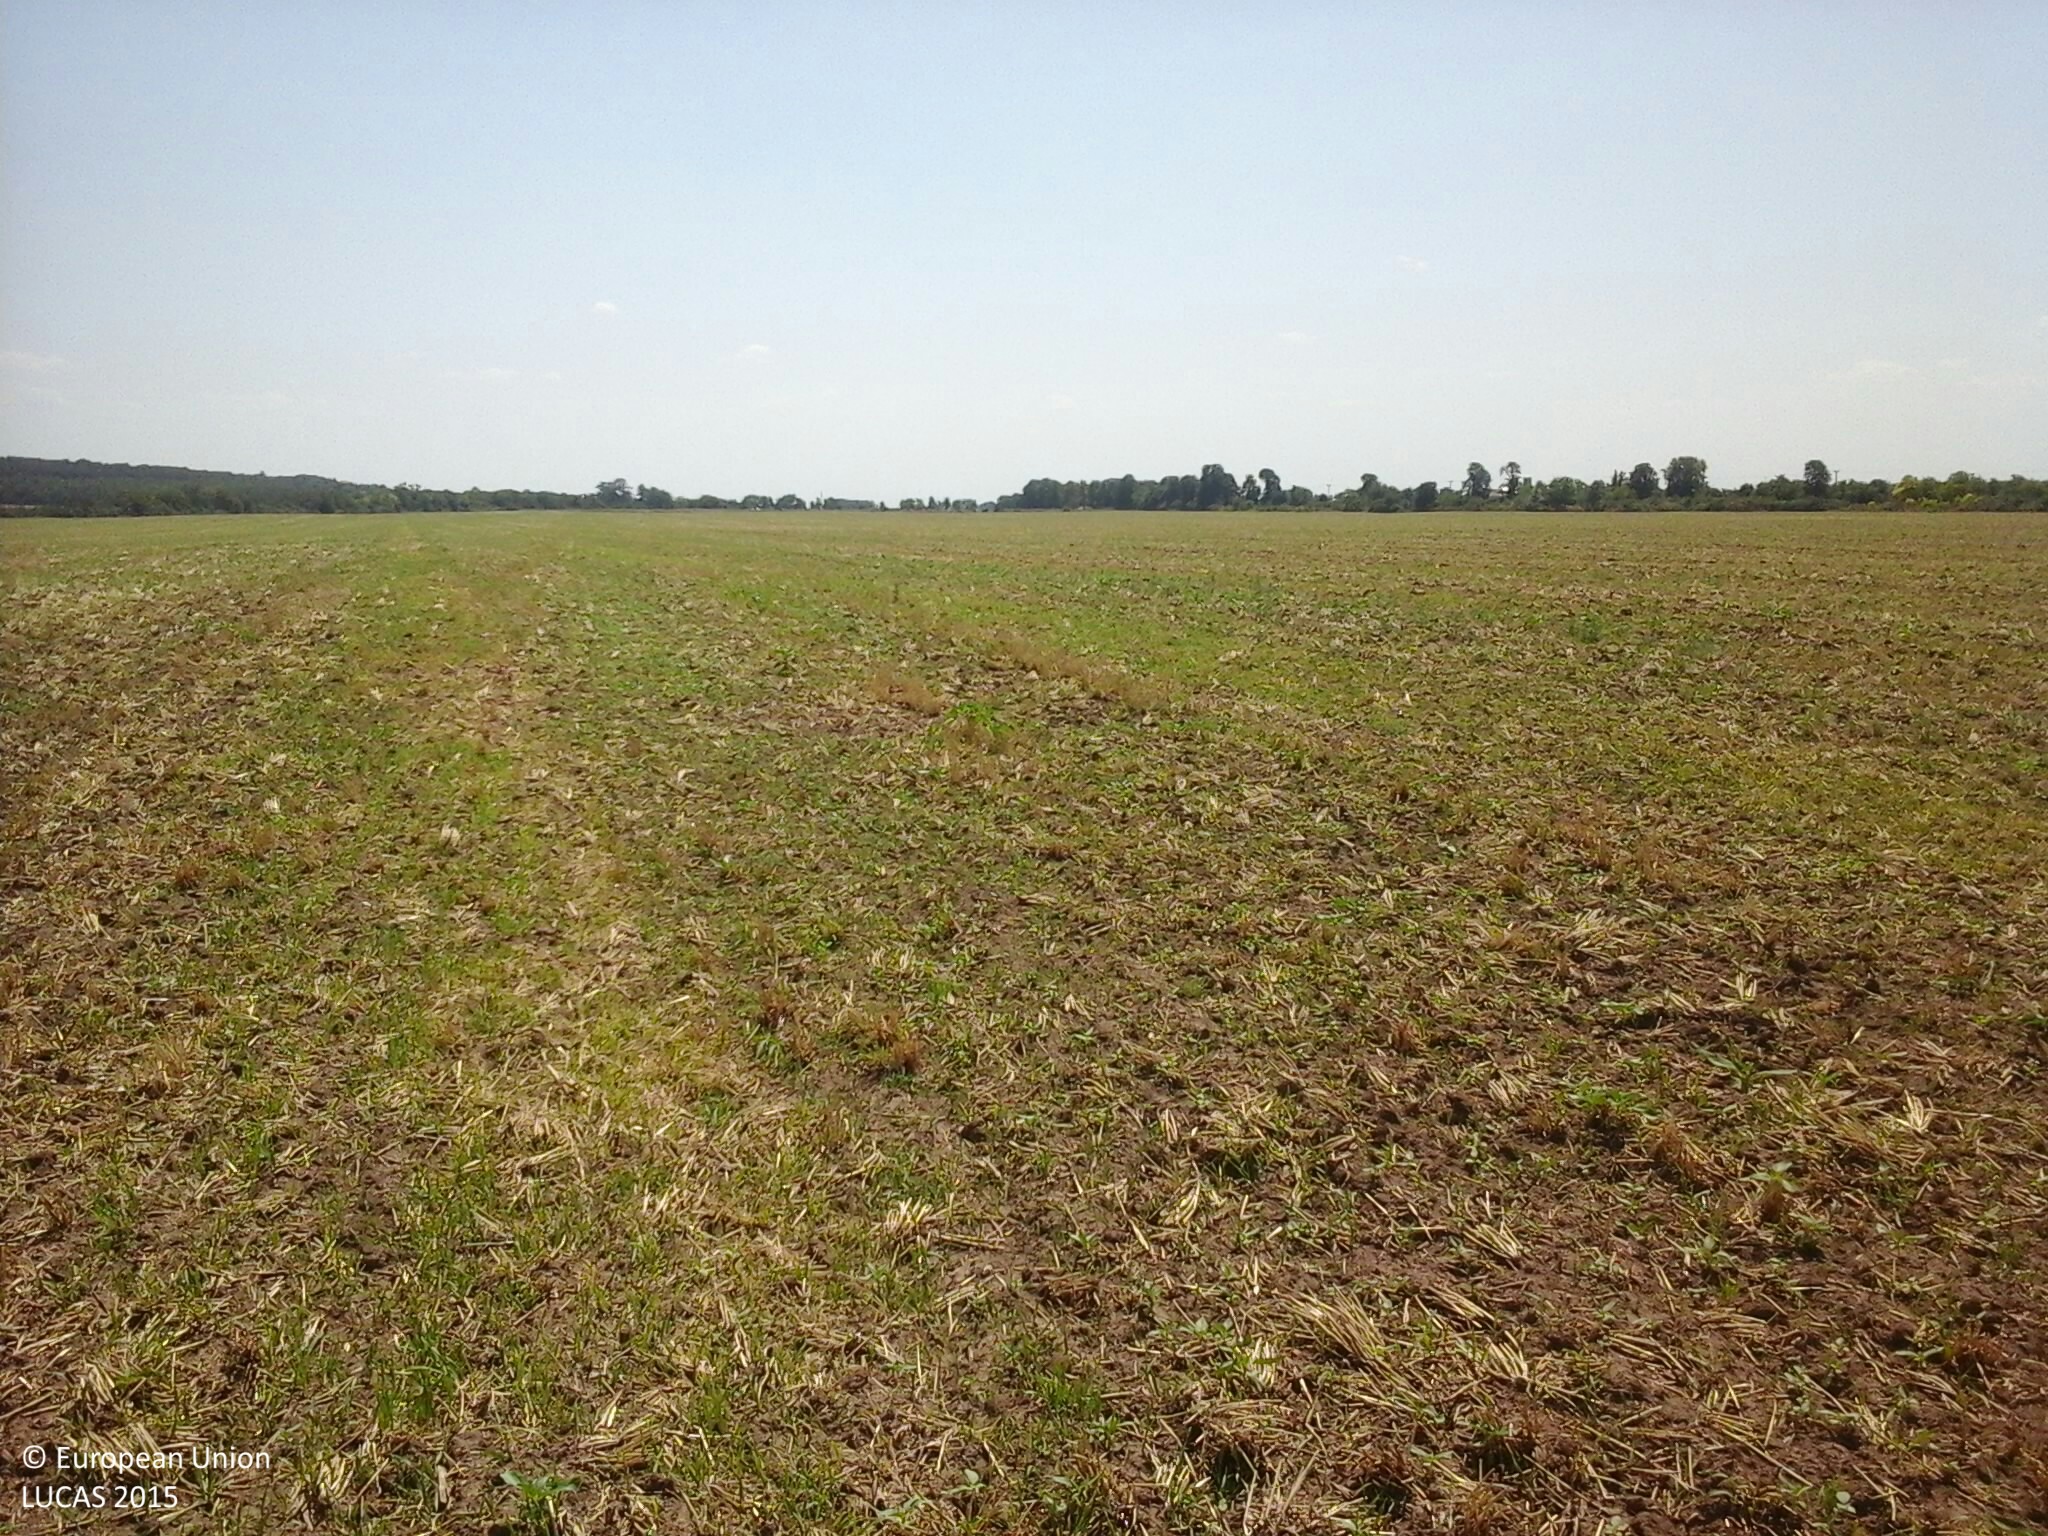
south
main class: Cropland
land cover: Common wheat
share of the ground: < 10 %
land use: Agriculture (excluding fallow land and kitchen gardens)
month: July
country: HU
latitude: 47.0823
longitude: 18.2429
